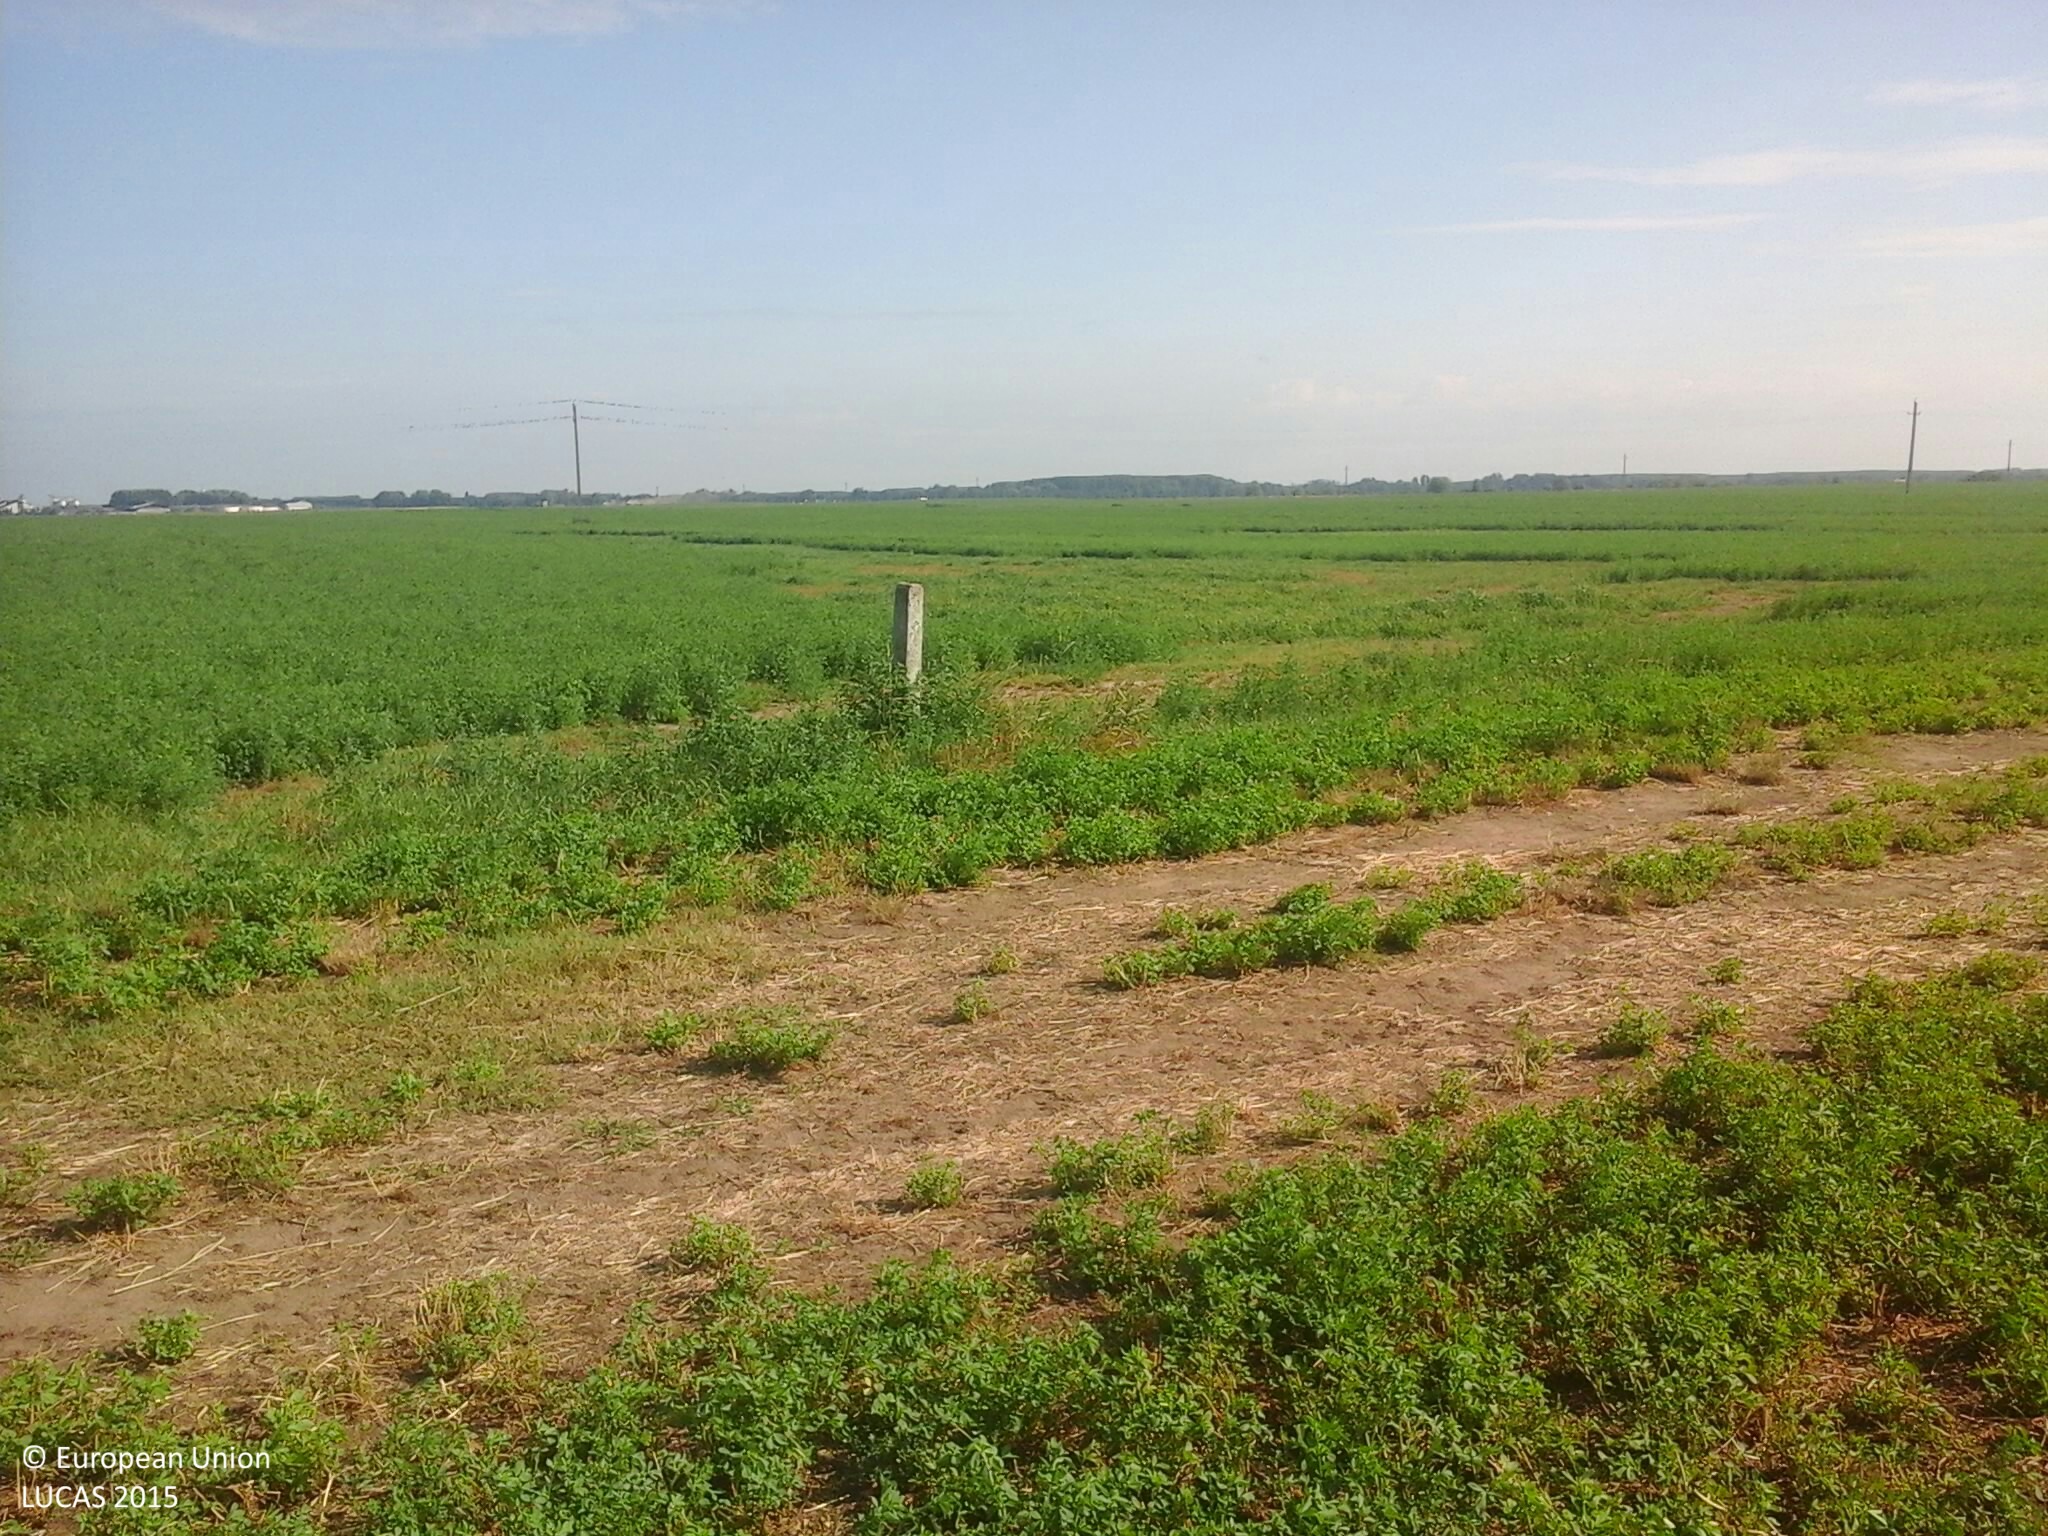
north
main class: Cropland
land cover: Lucerne
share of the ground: > 75 %
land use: Agriculture (excluding fallow land and kitchen gardens)
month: July
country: HU
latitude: 47.8018
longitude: 22.1635
